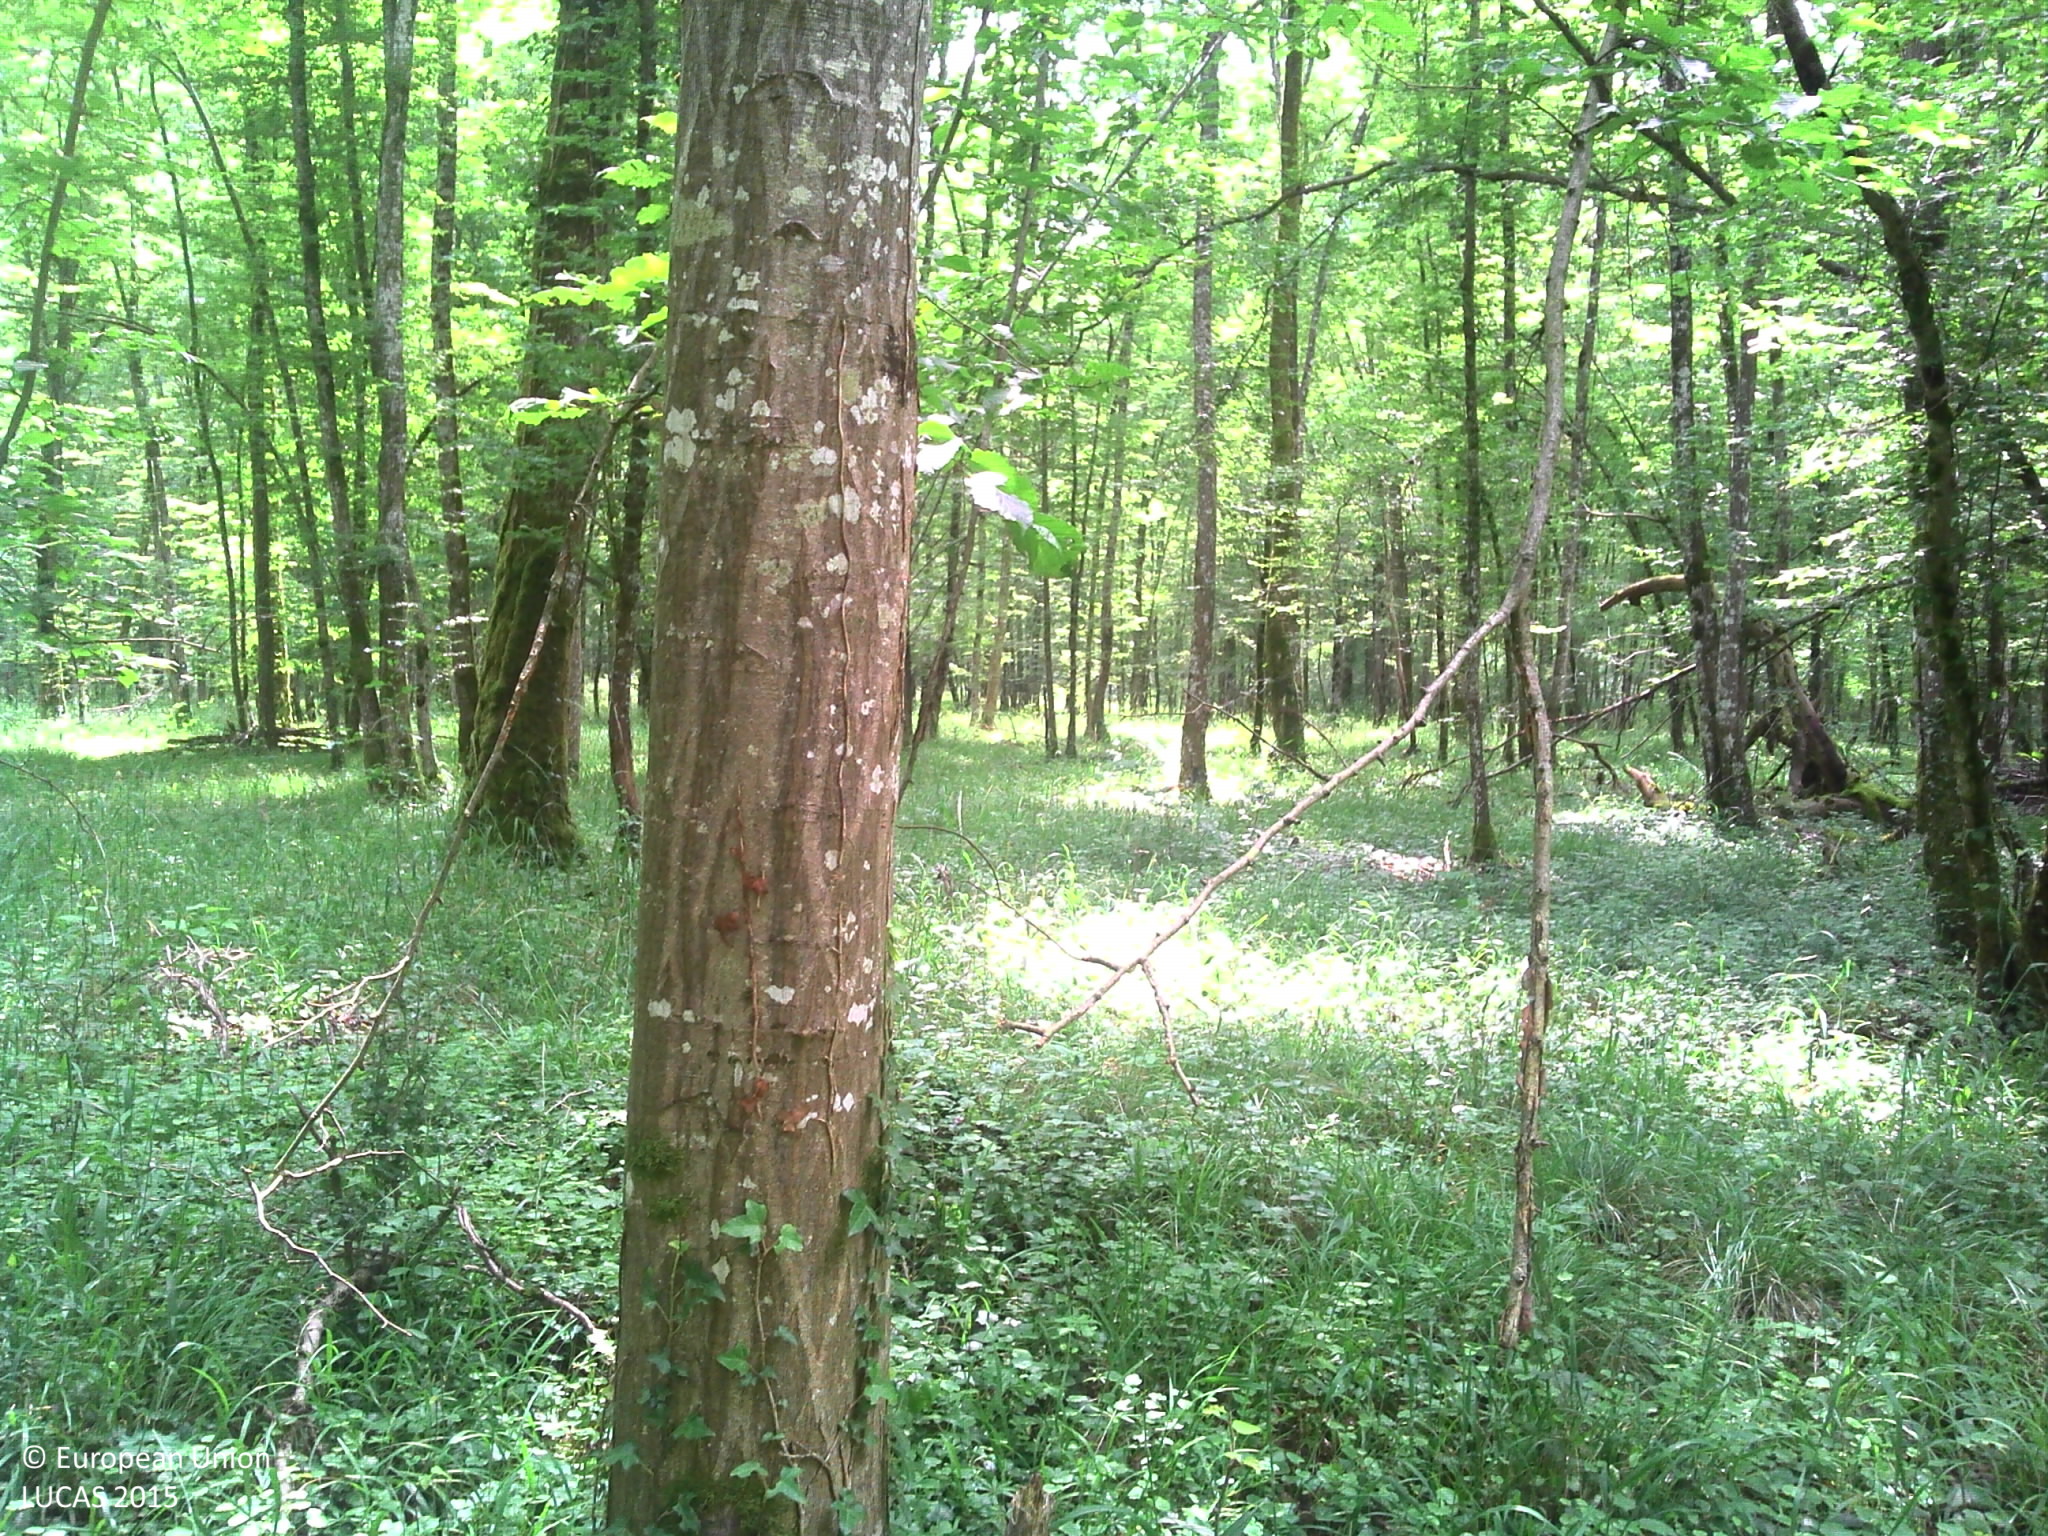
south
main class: Woodland
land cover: Broadleaved woodland
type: mesophytic deciduous forest
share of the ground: > 75 %
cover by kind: broadleaved forest trees 80 %, herbaceous plants 20 %
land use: Forestry
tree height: > 5 m
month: June
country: FR
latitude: 48.2377
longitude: 5.0305
